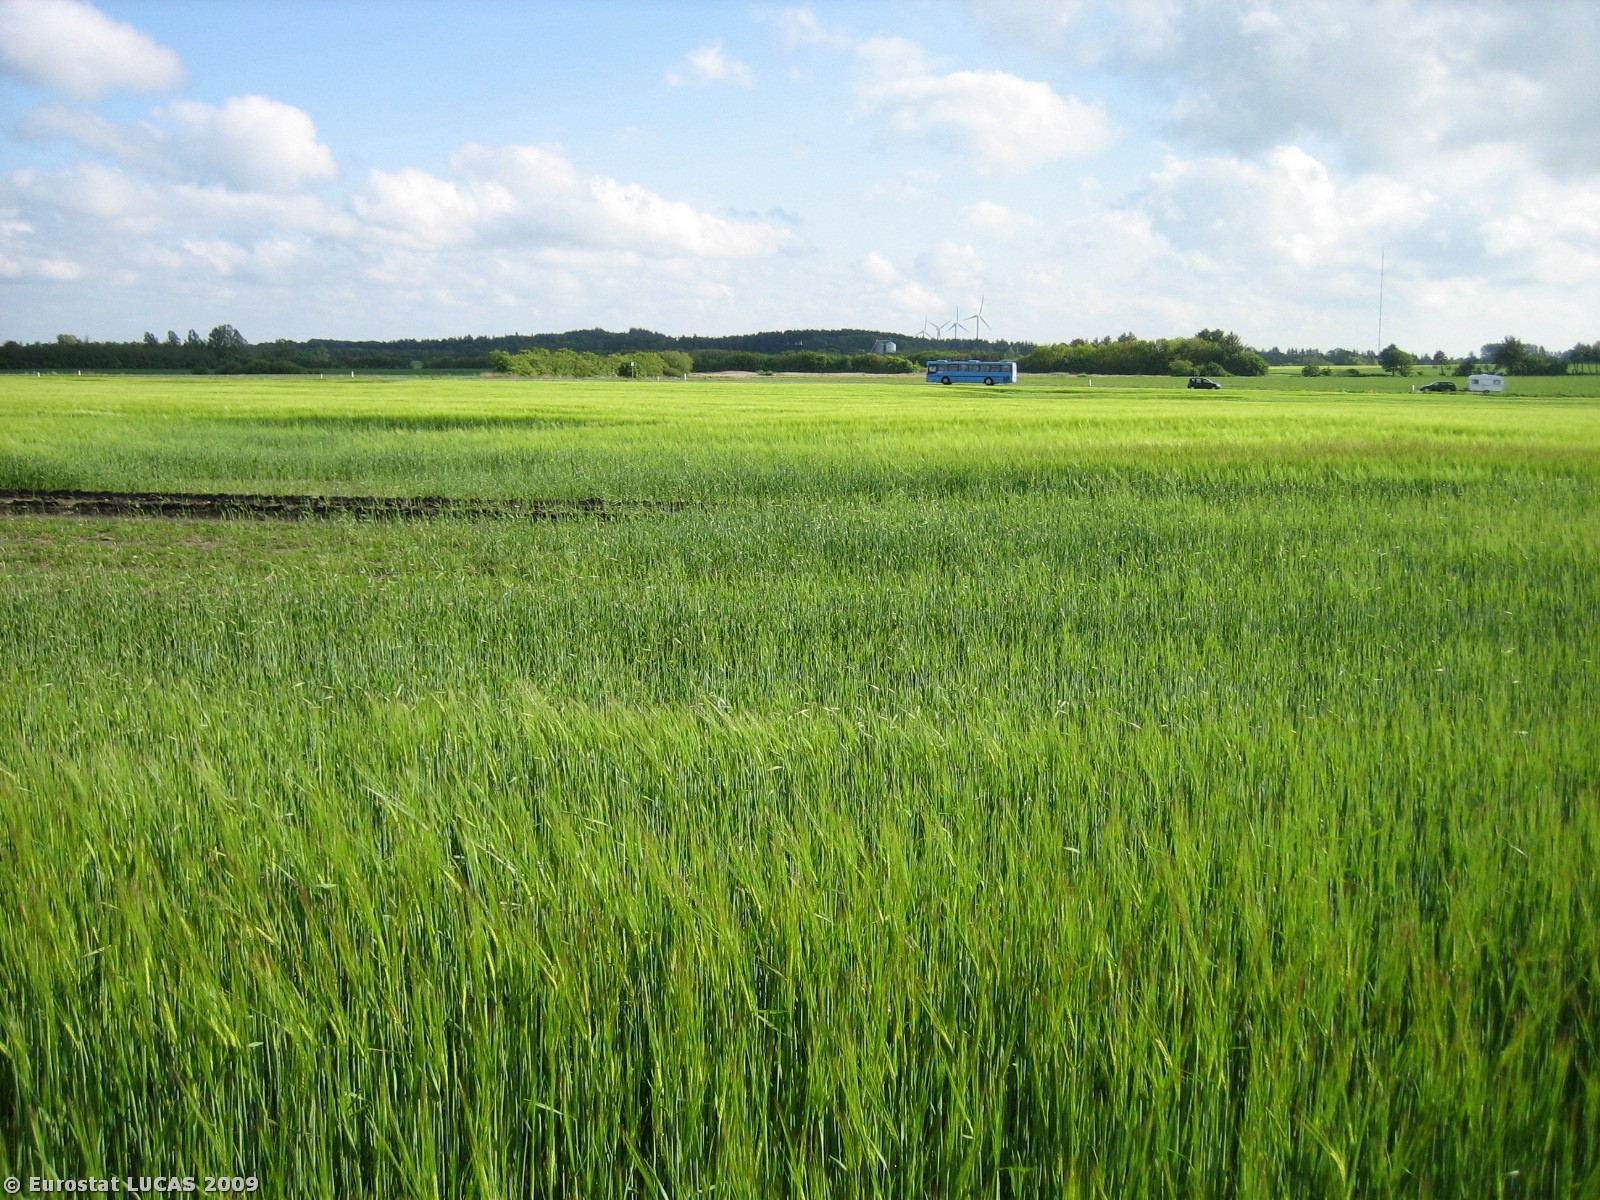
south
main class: Cropland
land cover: Barley
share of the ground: > 75 %
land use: Agriculture (excluding fallow land and kitchen gardens)
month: May
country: DK
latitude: 56.1814
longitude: 8.7287
